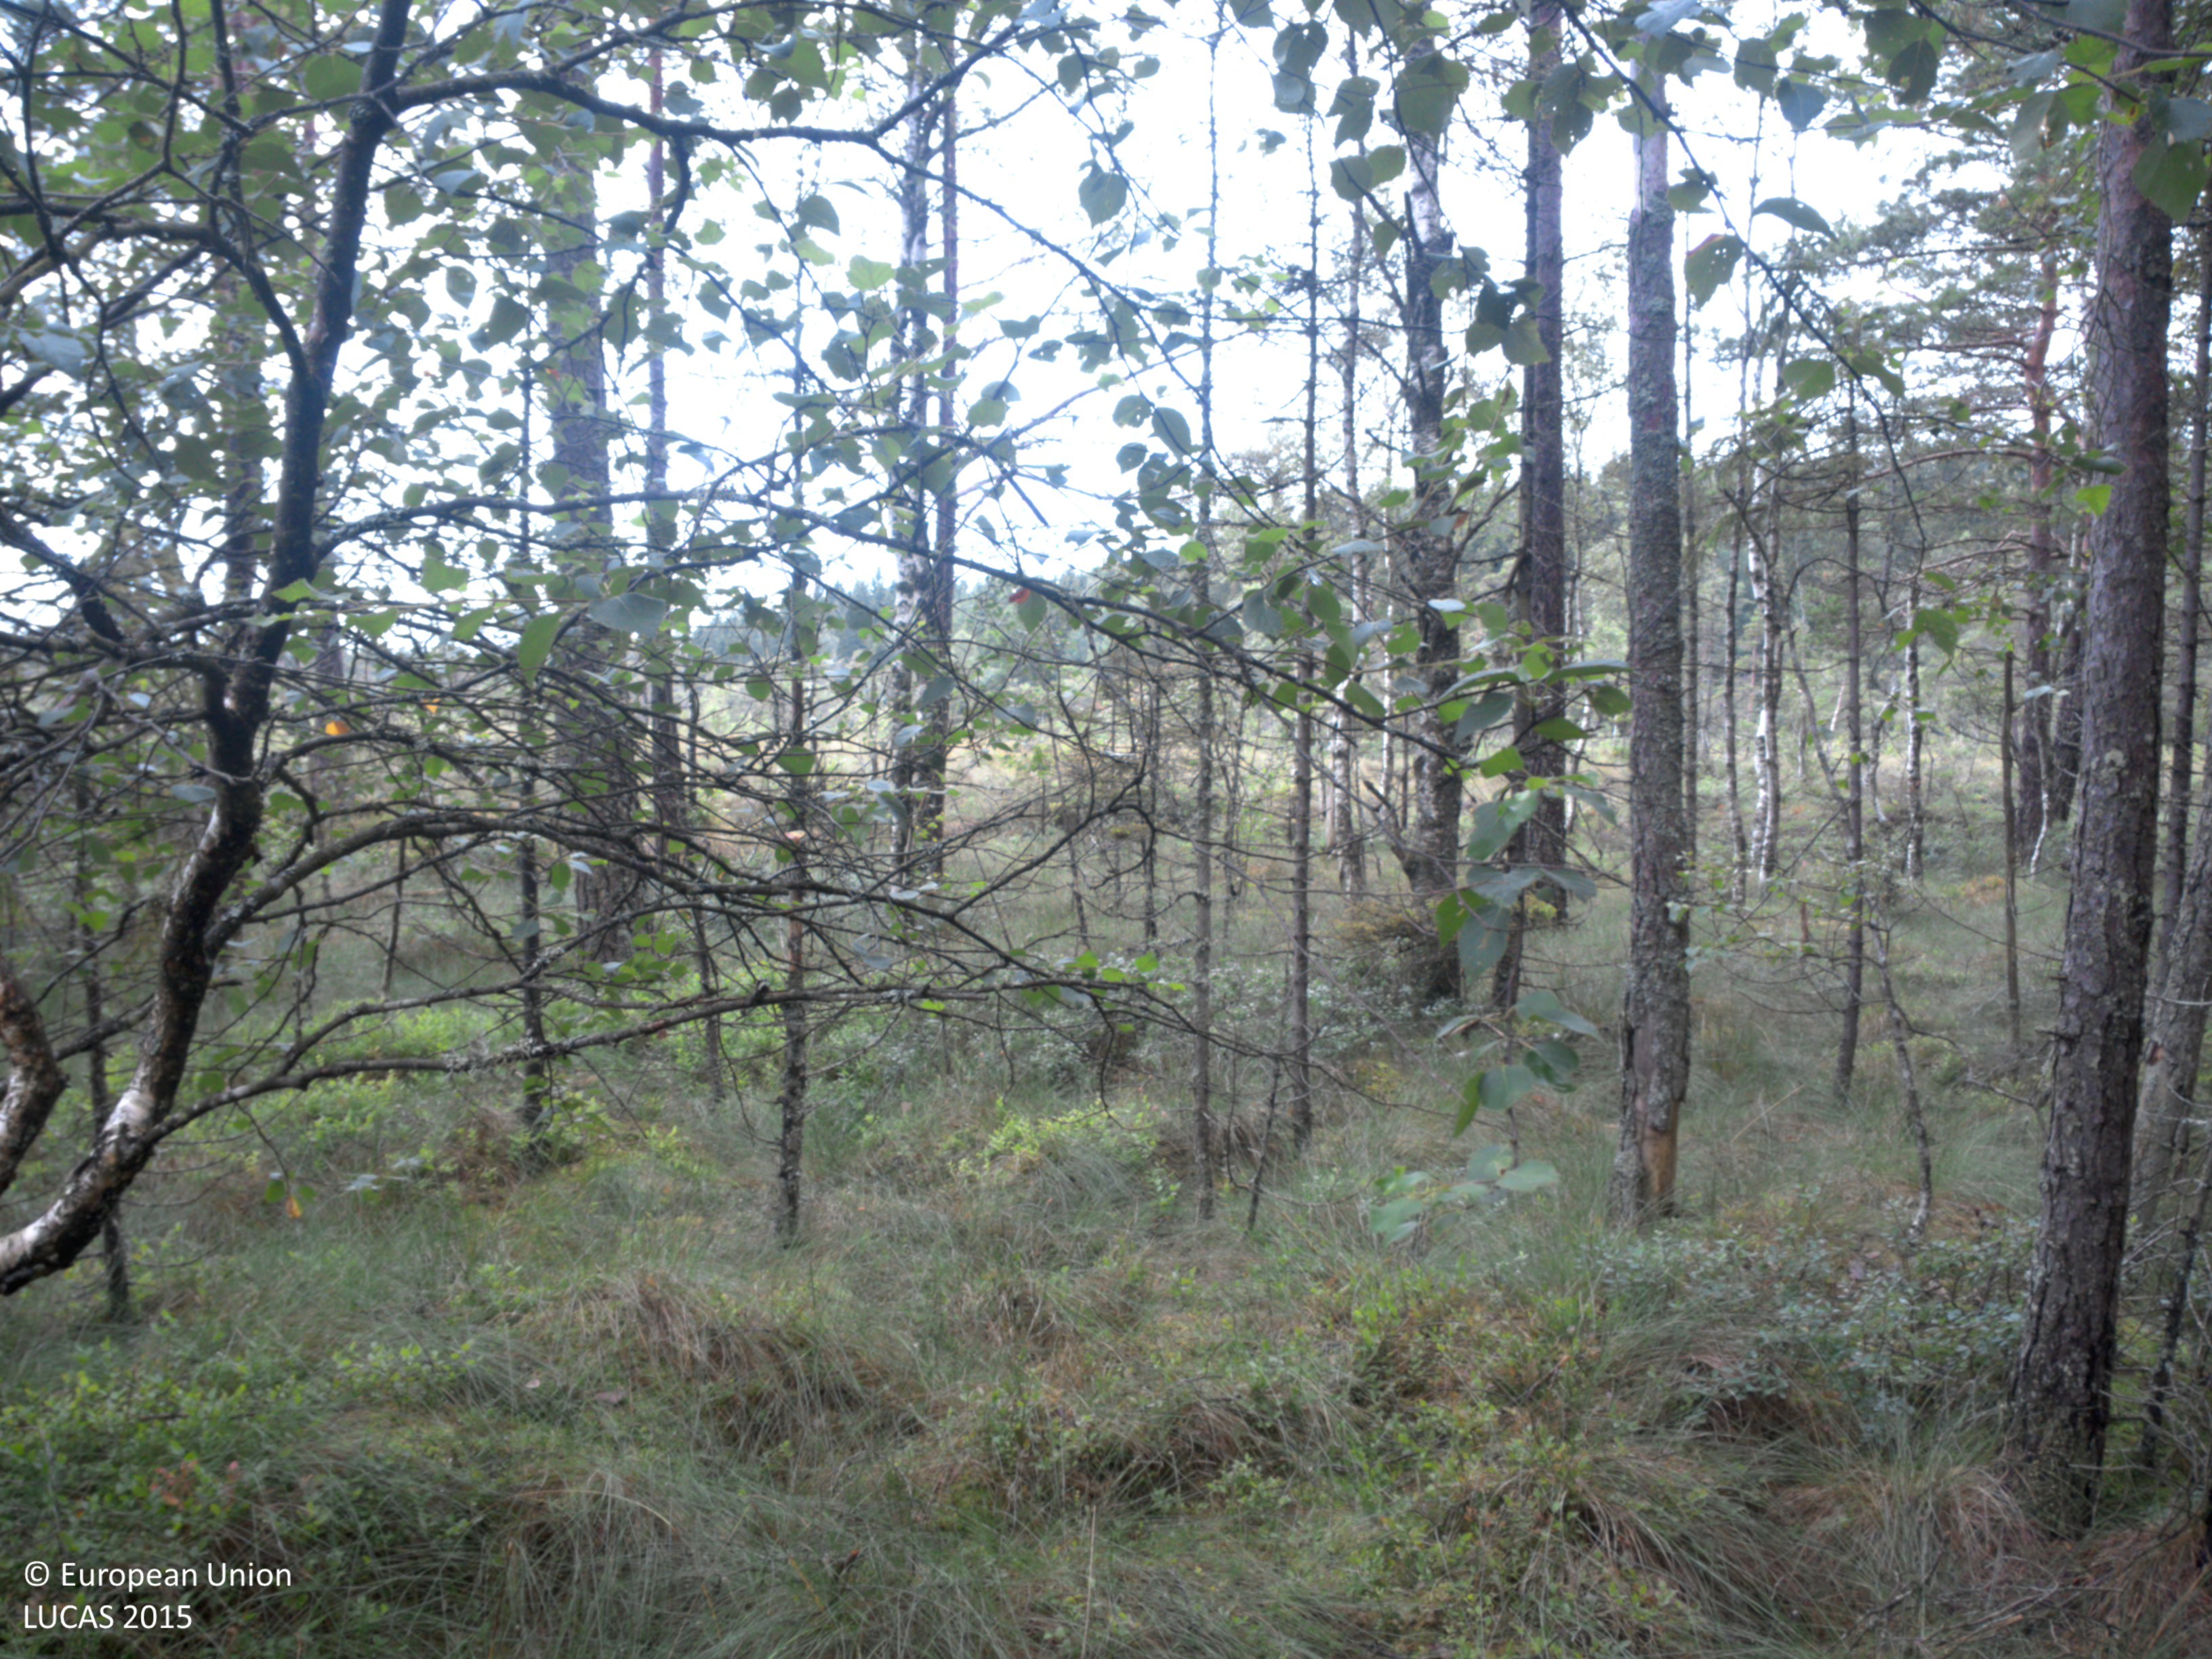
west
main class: Woodland
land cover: Pine dominated mixed woodland
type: boreal forest
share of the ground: 50 - 75 %
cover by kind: lichens and mosses 50 %, coniferous forest trees 30 %, broadleaved forest trees 20 %
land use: Semi-natural and natural areas not in use
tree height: < 5 m
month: July
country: SE
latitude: 58.6183
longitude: 12.0101
